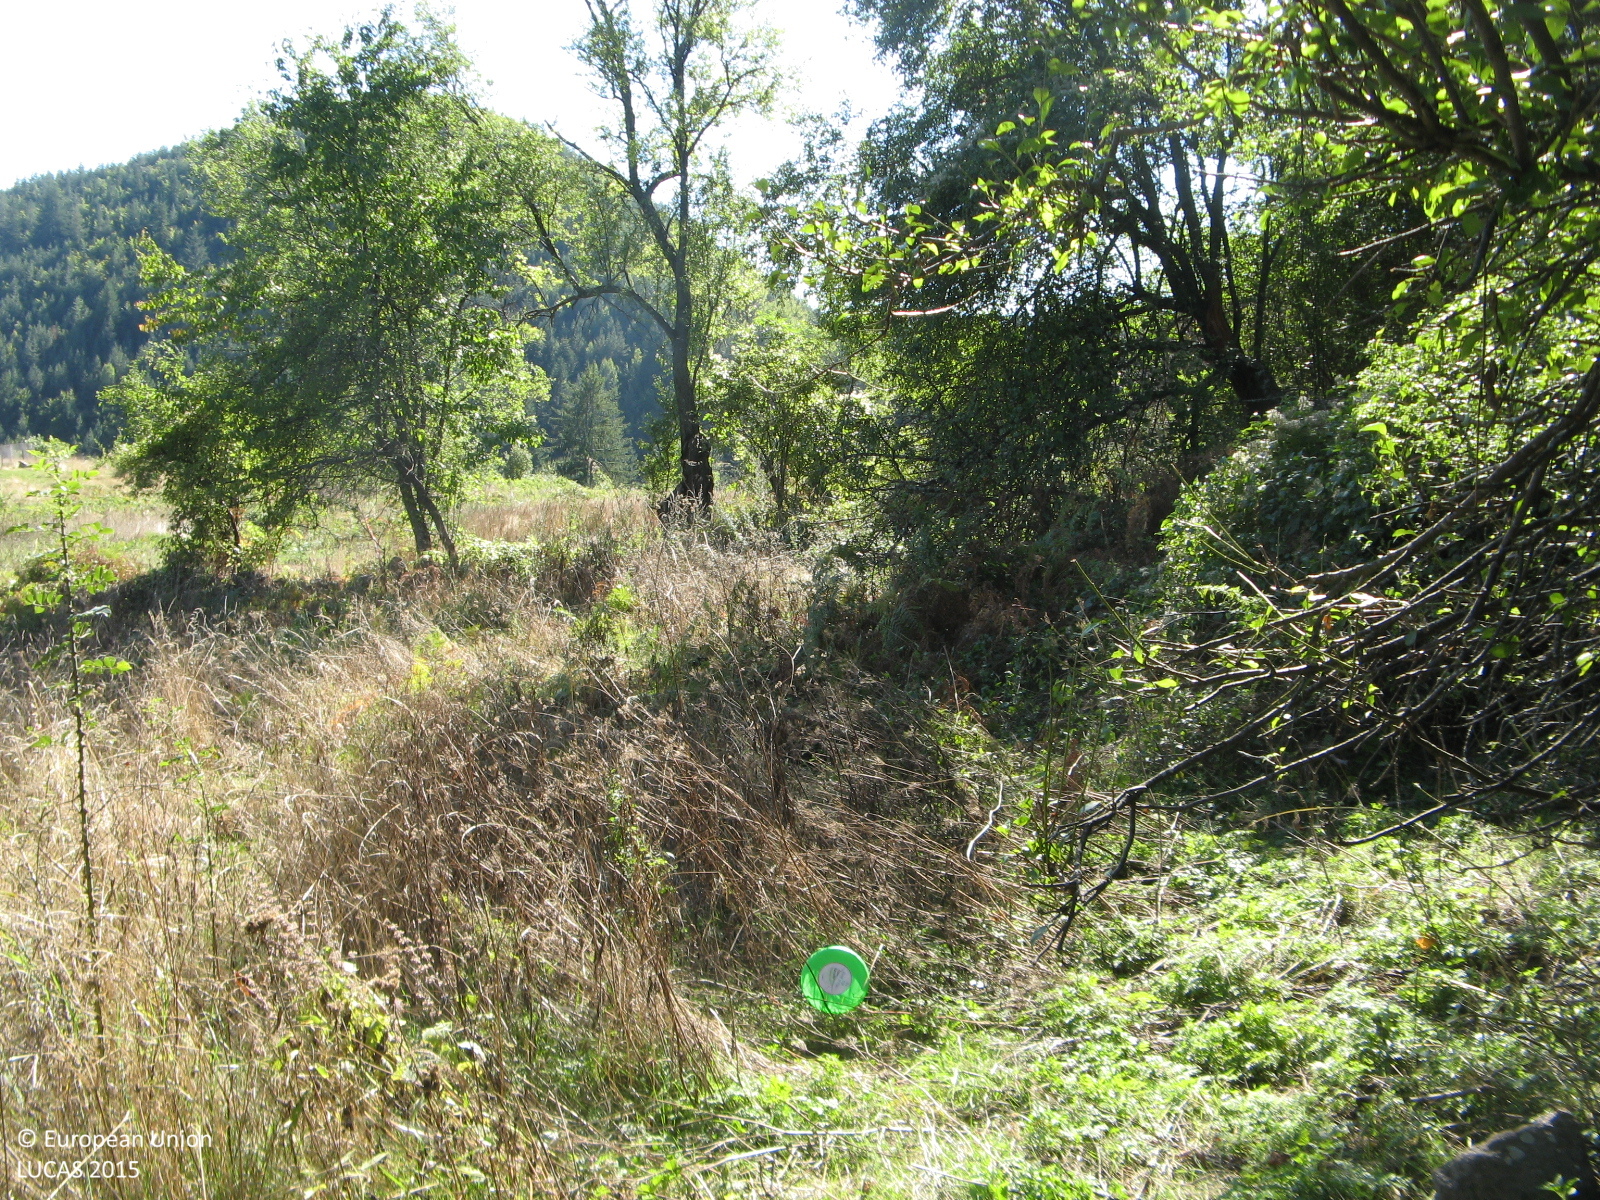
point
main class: Grassland
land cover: Grassland with sparse tree/shrub cover
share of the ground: > 75 %
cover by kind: herbaceous plants 85 %, shrubs 10 %, broadleaved forest trees 5 %
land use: Agriculture (excluding fallow land and kitchen gardens)
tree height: > 5 m
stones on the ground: < 10 %
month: October
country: BG
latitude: 41.5908
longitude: 24.7156
